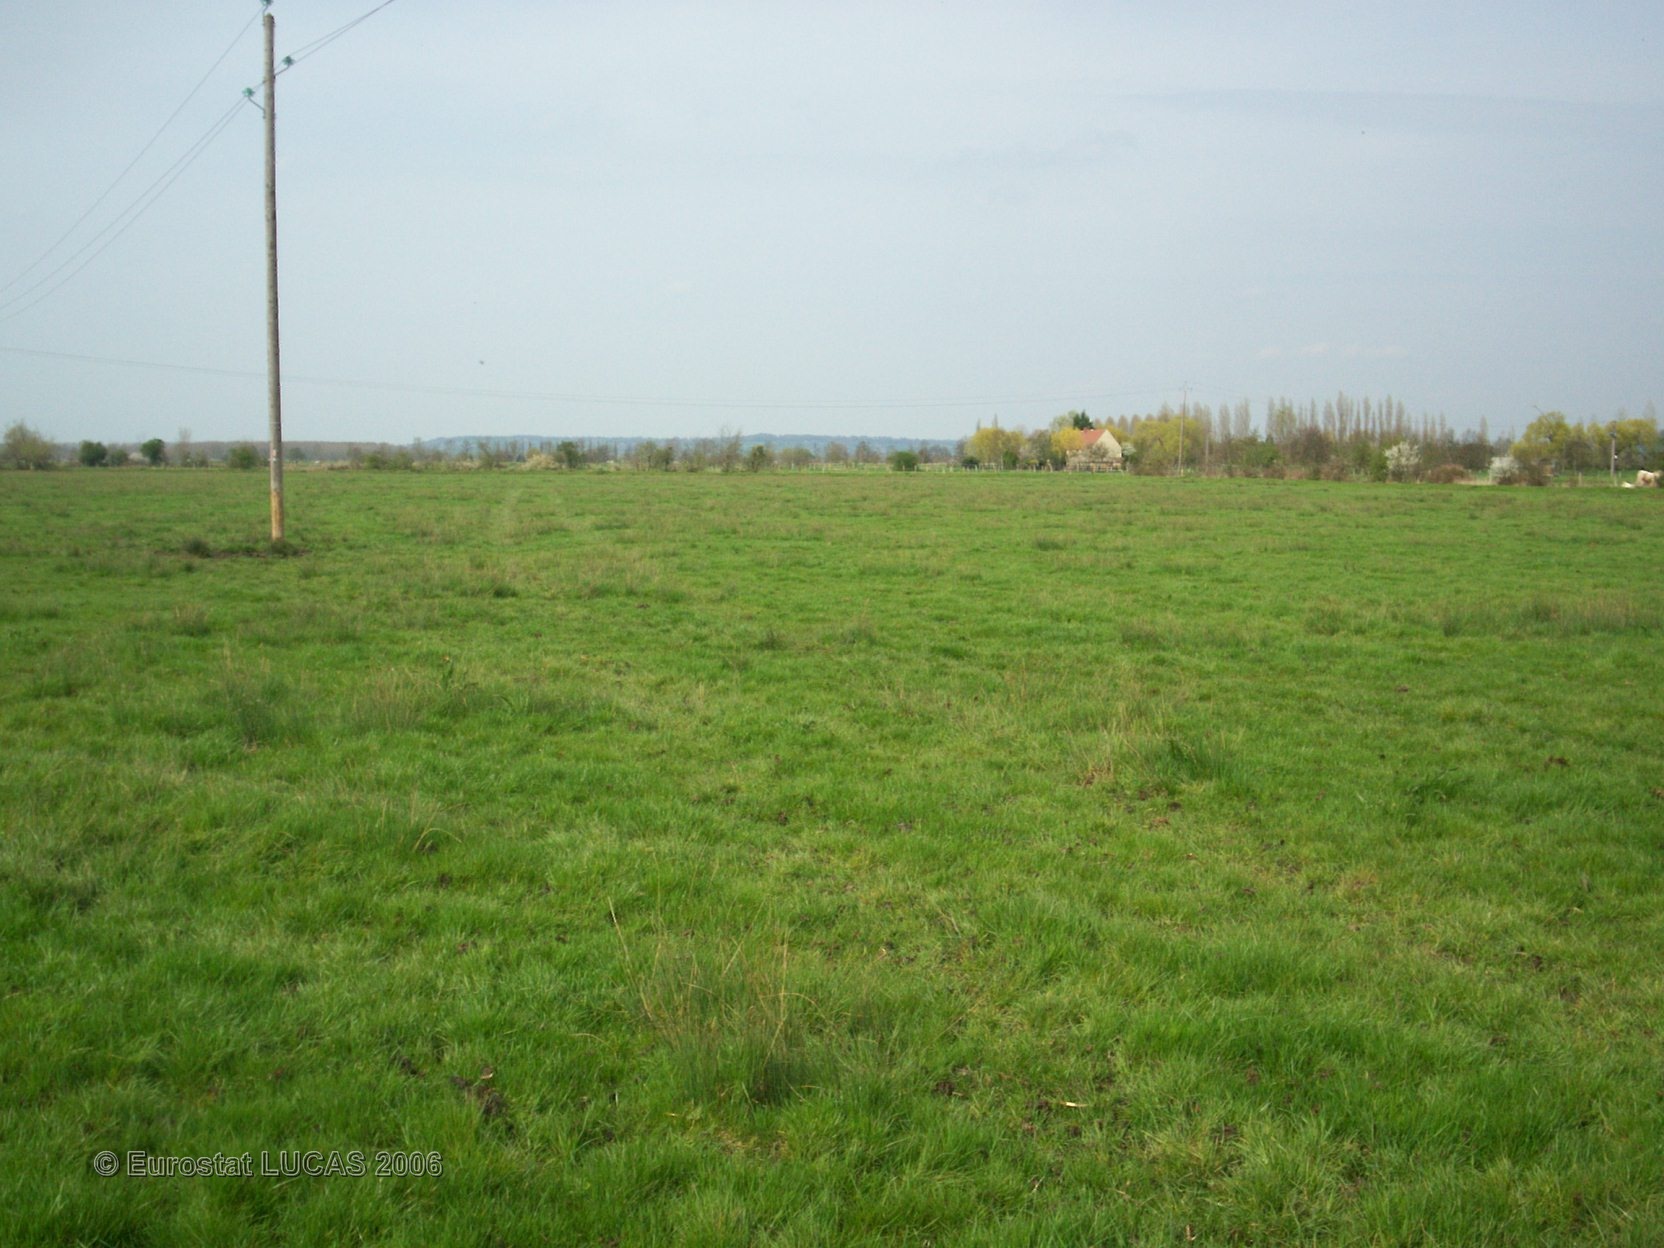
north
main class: Grassland
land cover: Grassland without tree/shrub cover
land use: Agriculture (excluding fallow land and kitchen gardens)
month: April
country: FR
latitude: 49.1254
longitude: -0.0209
